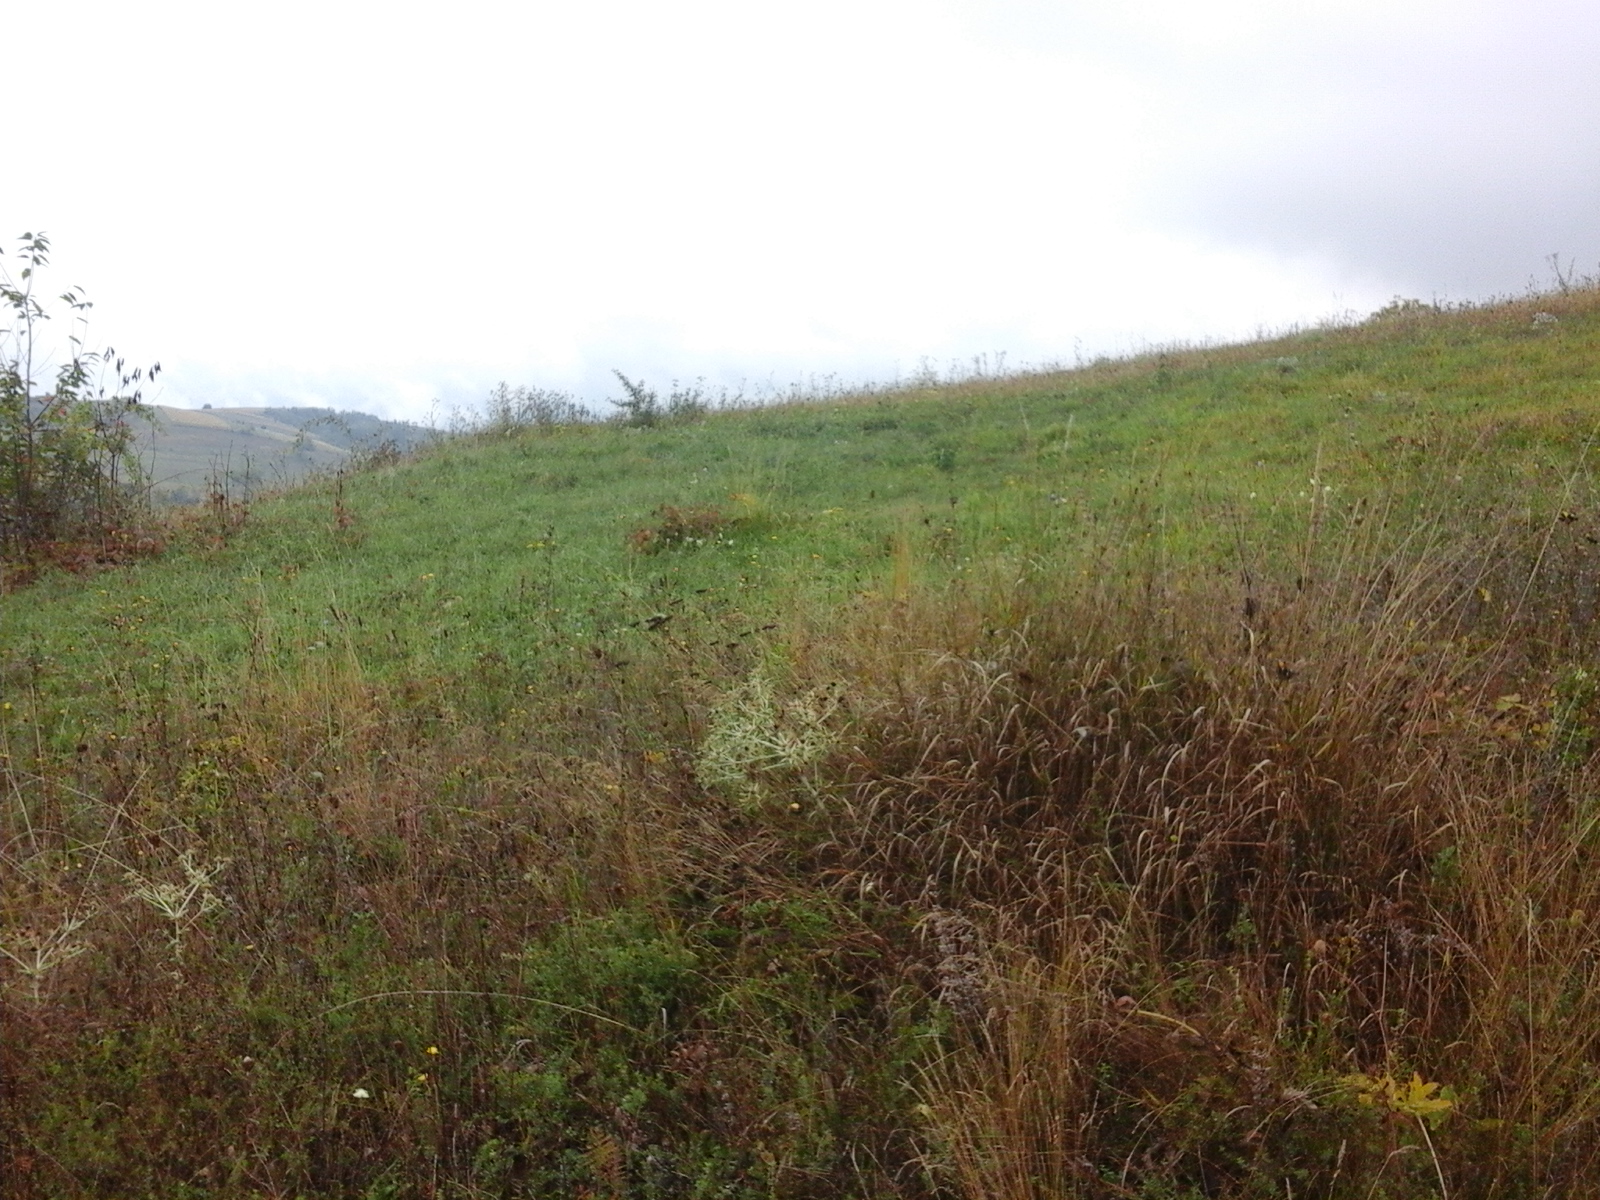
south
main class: Grassland
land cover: Spontaneously vegetated surfaces
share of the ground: > 75 %
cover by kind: herbaceous plants 100 %
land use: Fallow land
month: September
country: RO
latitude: 46.7236
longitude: 22.2034
